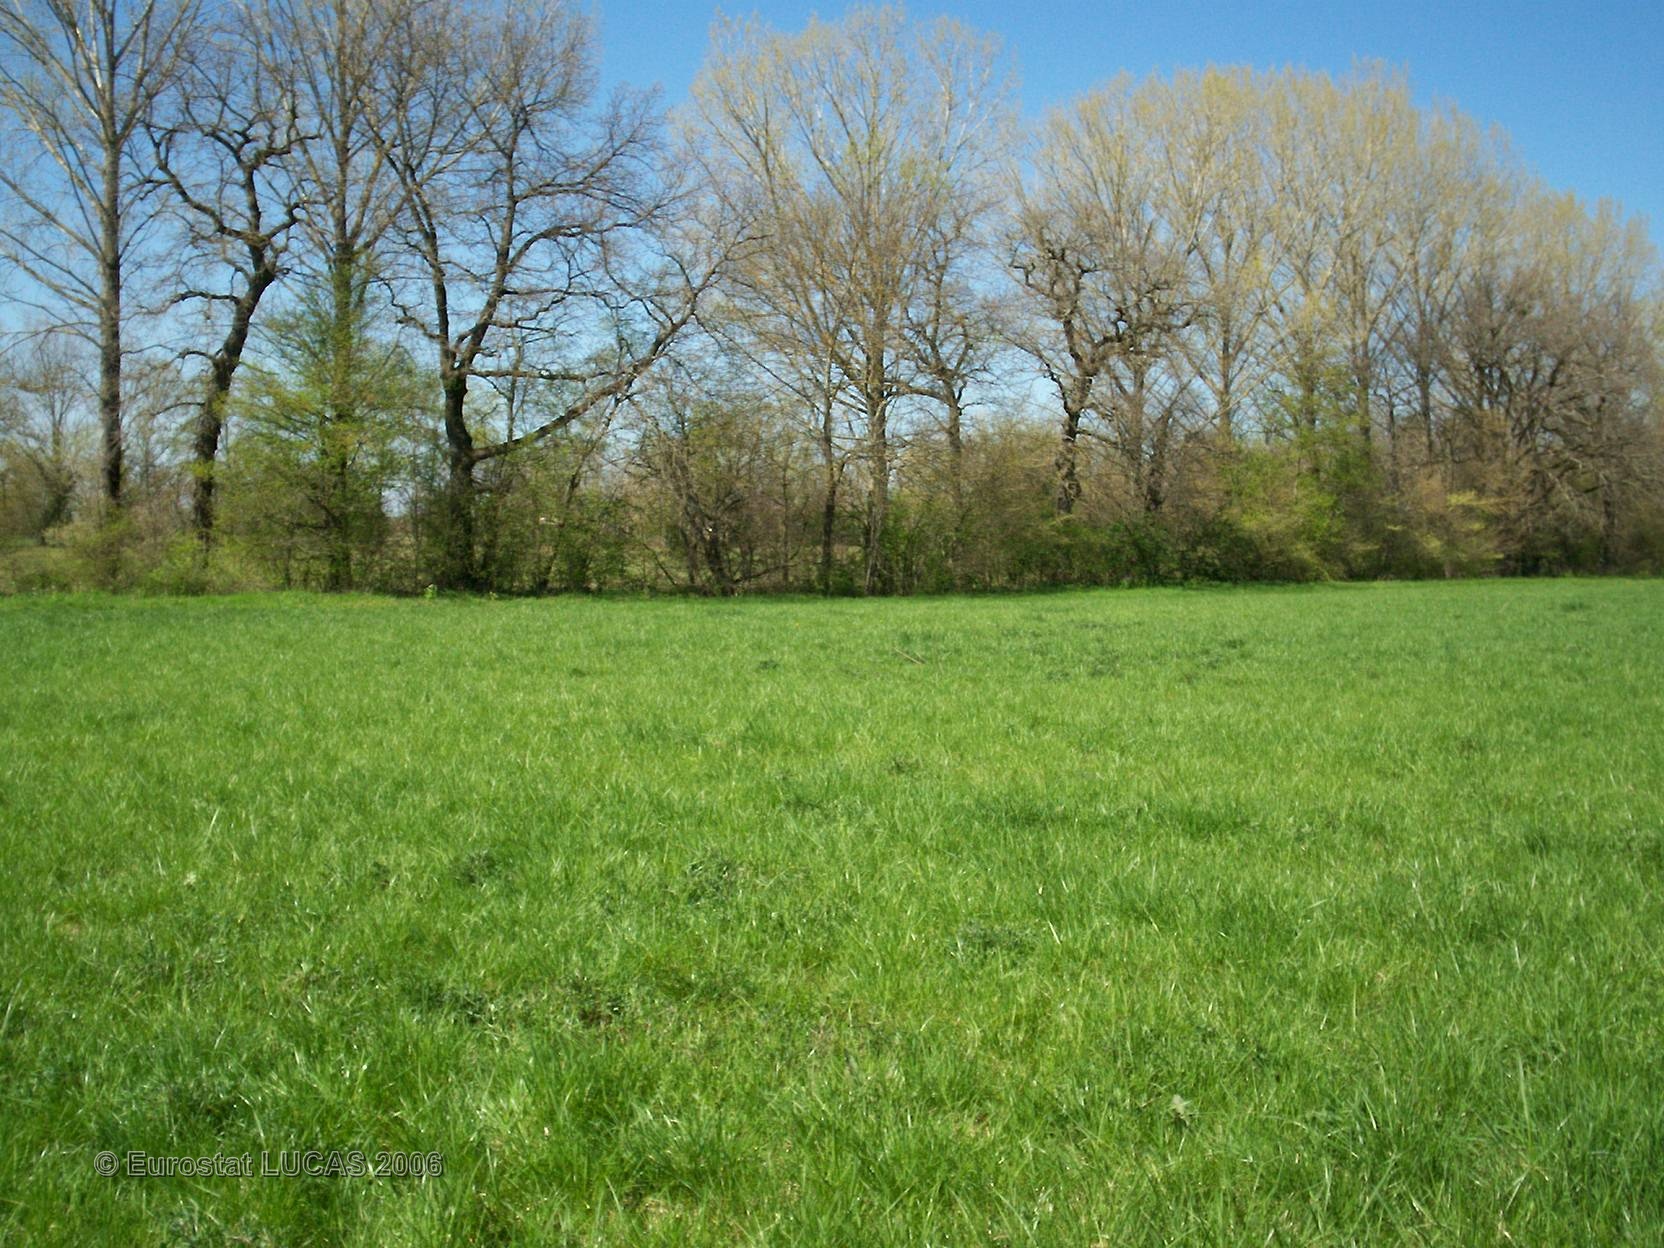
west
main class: Grassland
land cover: Grassland without tree/shrub cover
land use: Agriculture (excluding fallow land and kitchen gardens)
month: April
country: FR
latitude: 43.5198
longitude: 2.0506
